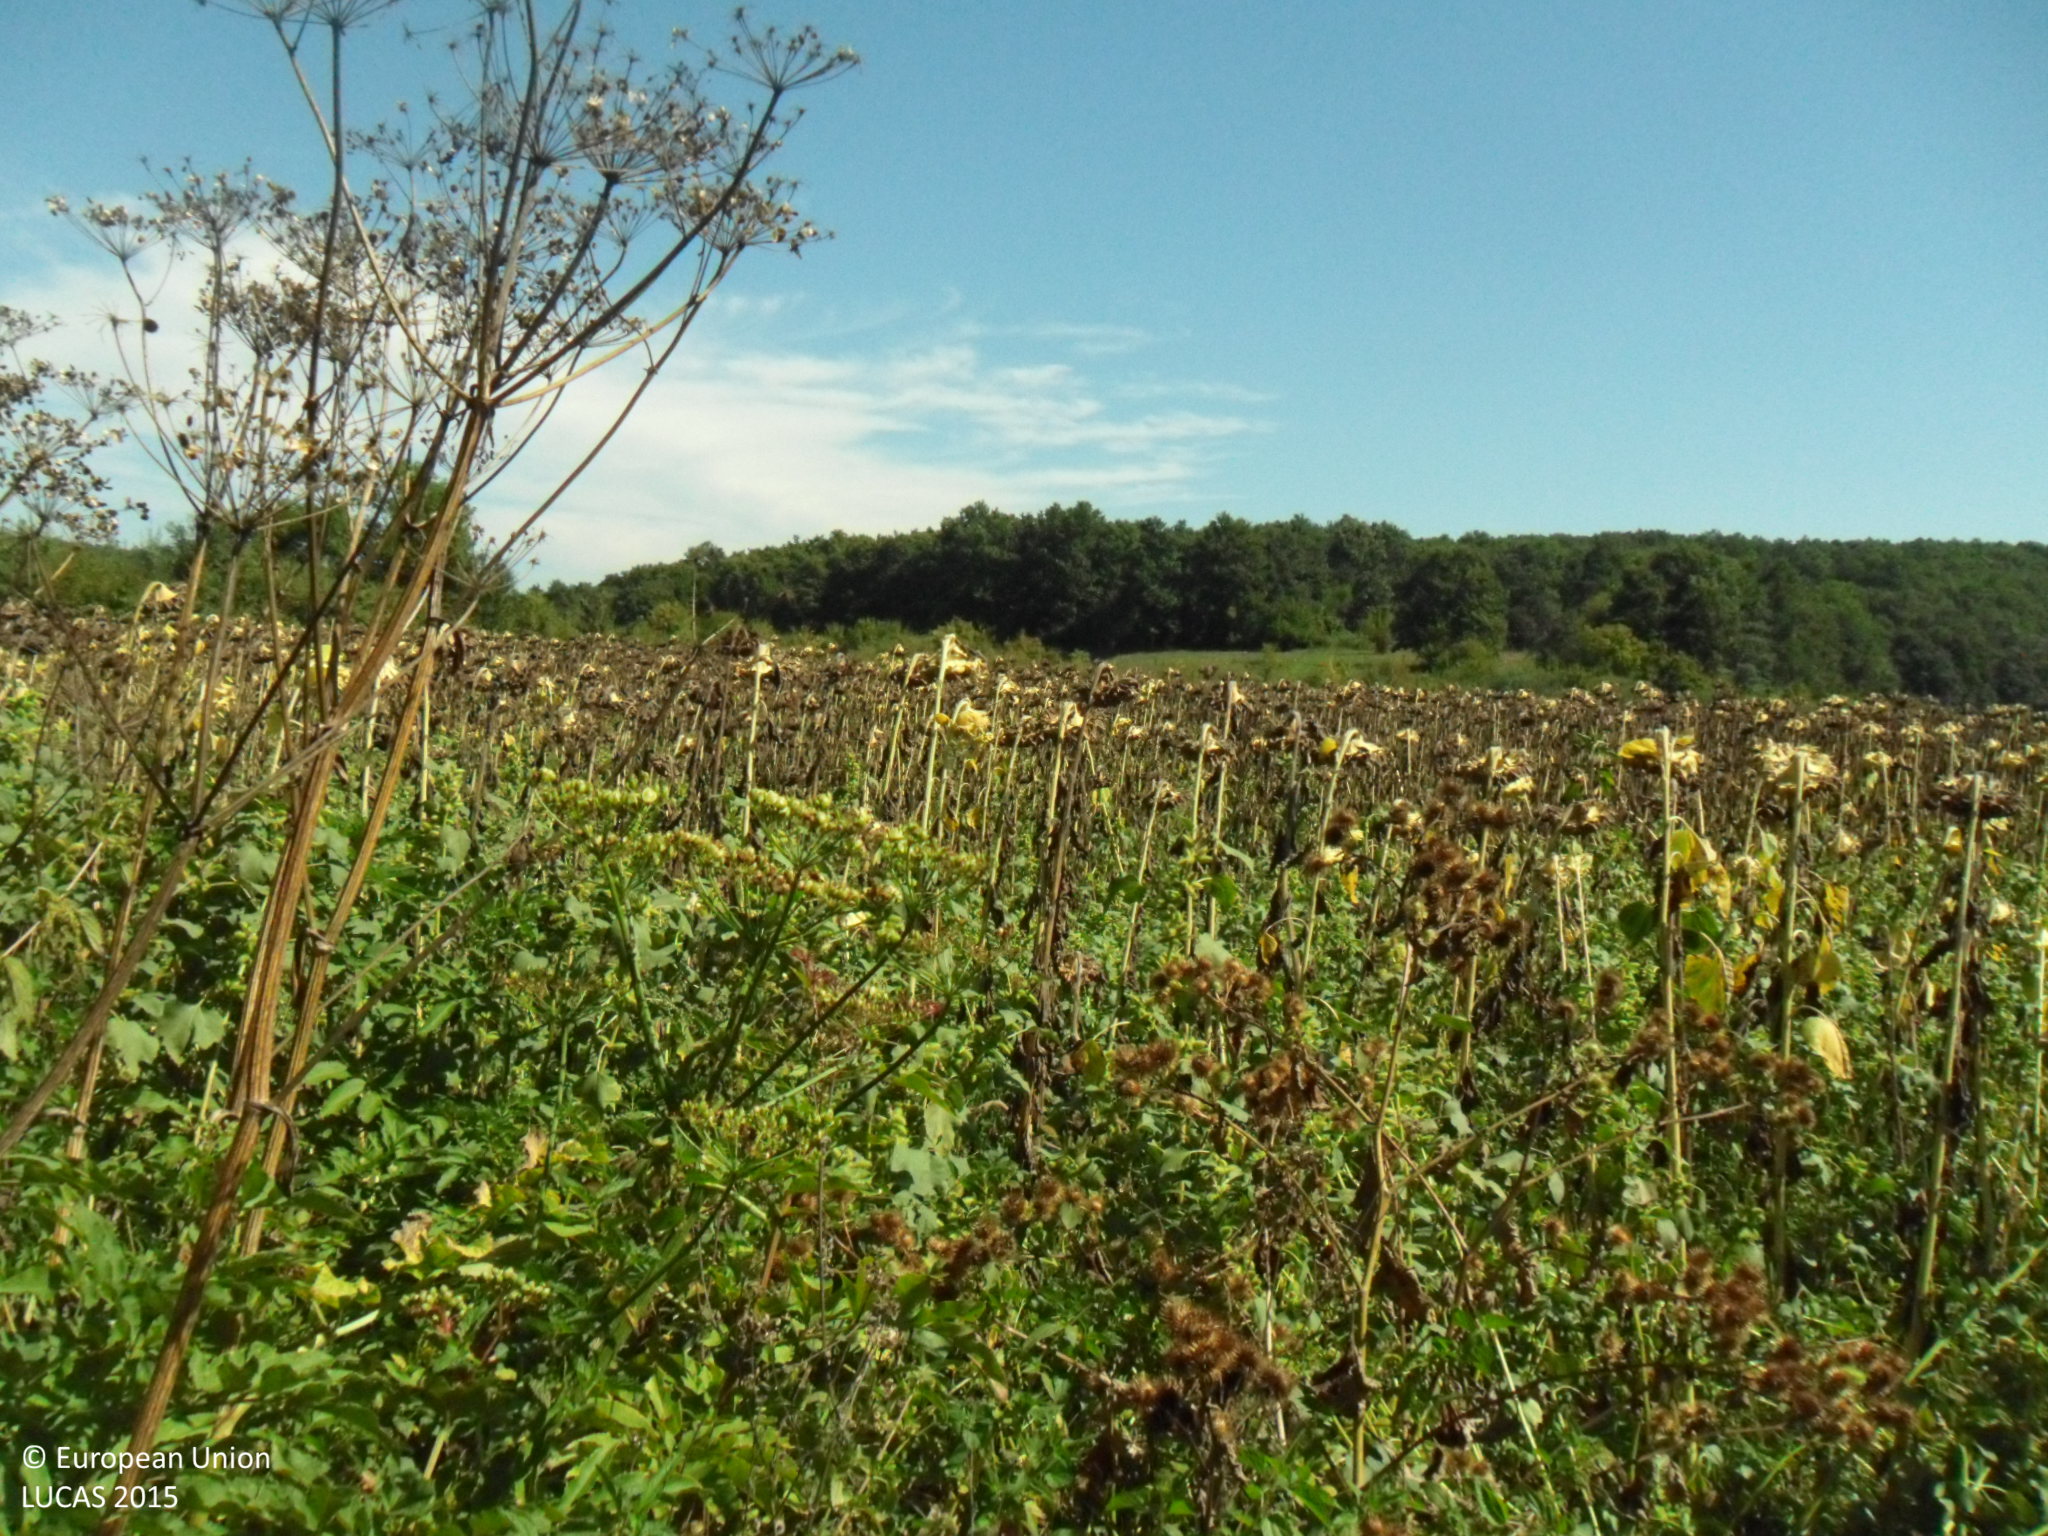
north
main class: Shrubland
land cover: Shrubland with sparse tree cover
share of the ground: > 75 %
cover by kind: shrubs 95 %, broadleaved forest trees 5 %
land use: Forestry
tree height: > 5 m
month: September
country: BG
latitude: 43.6644
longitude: 27.1502
